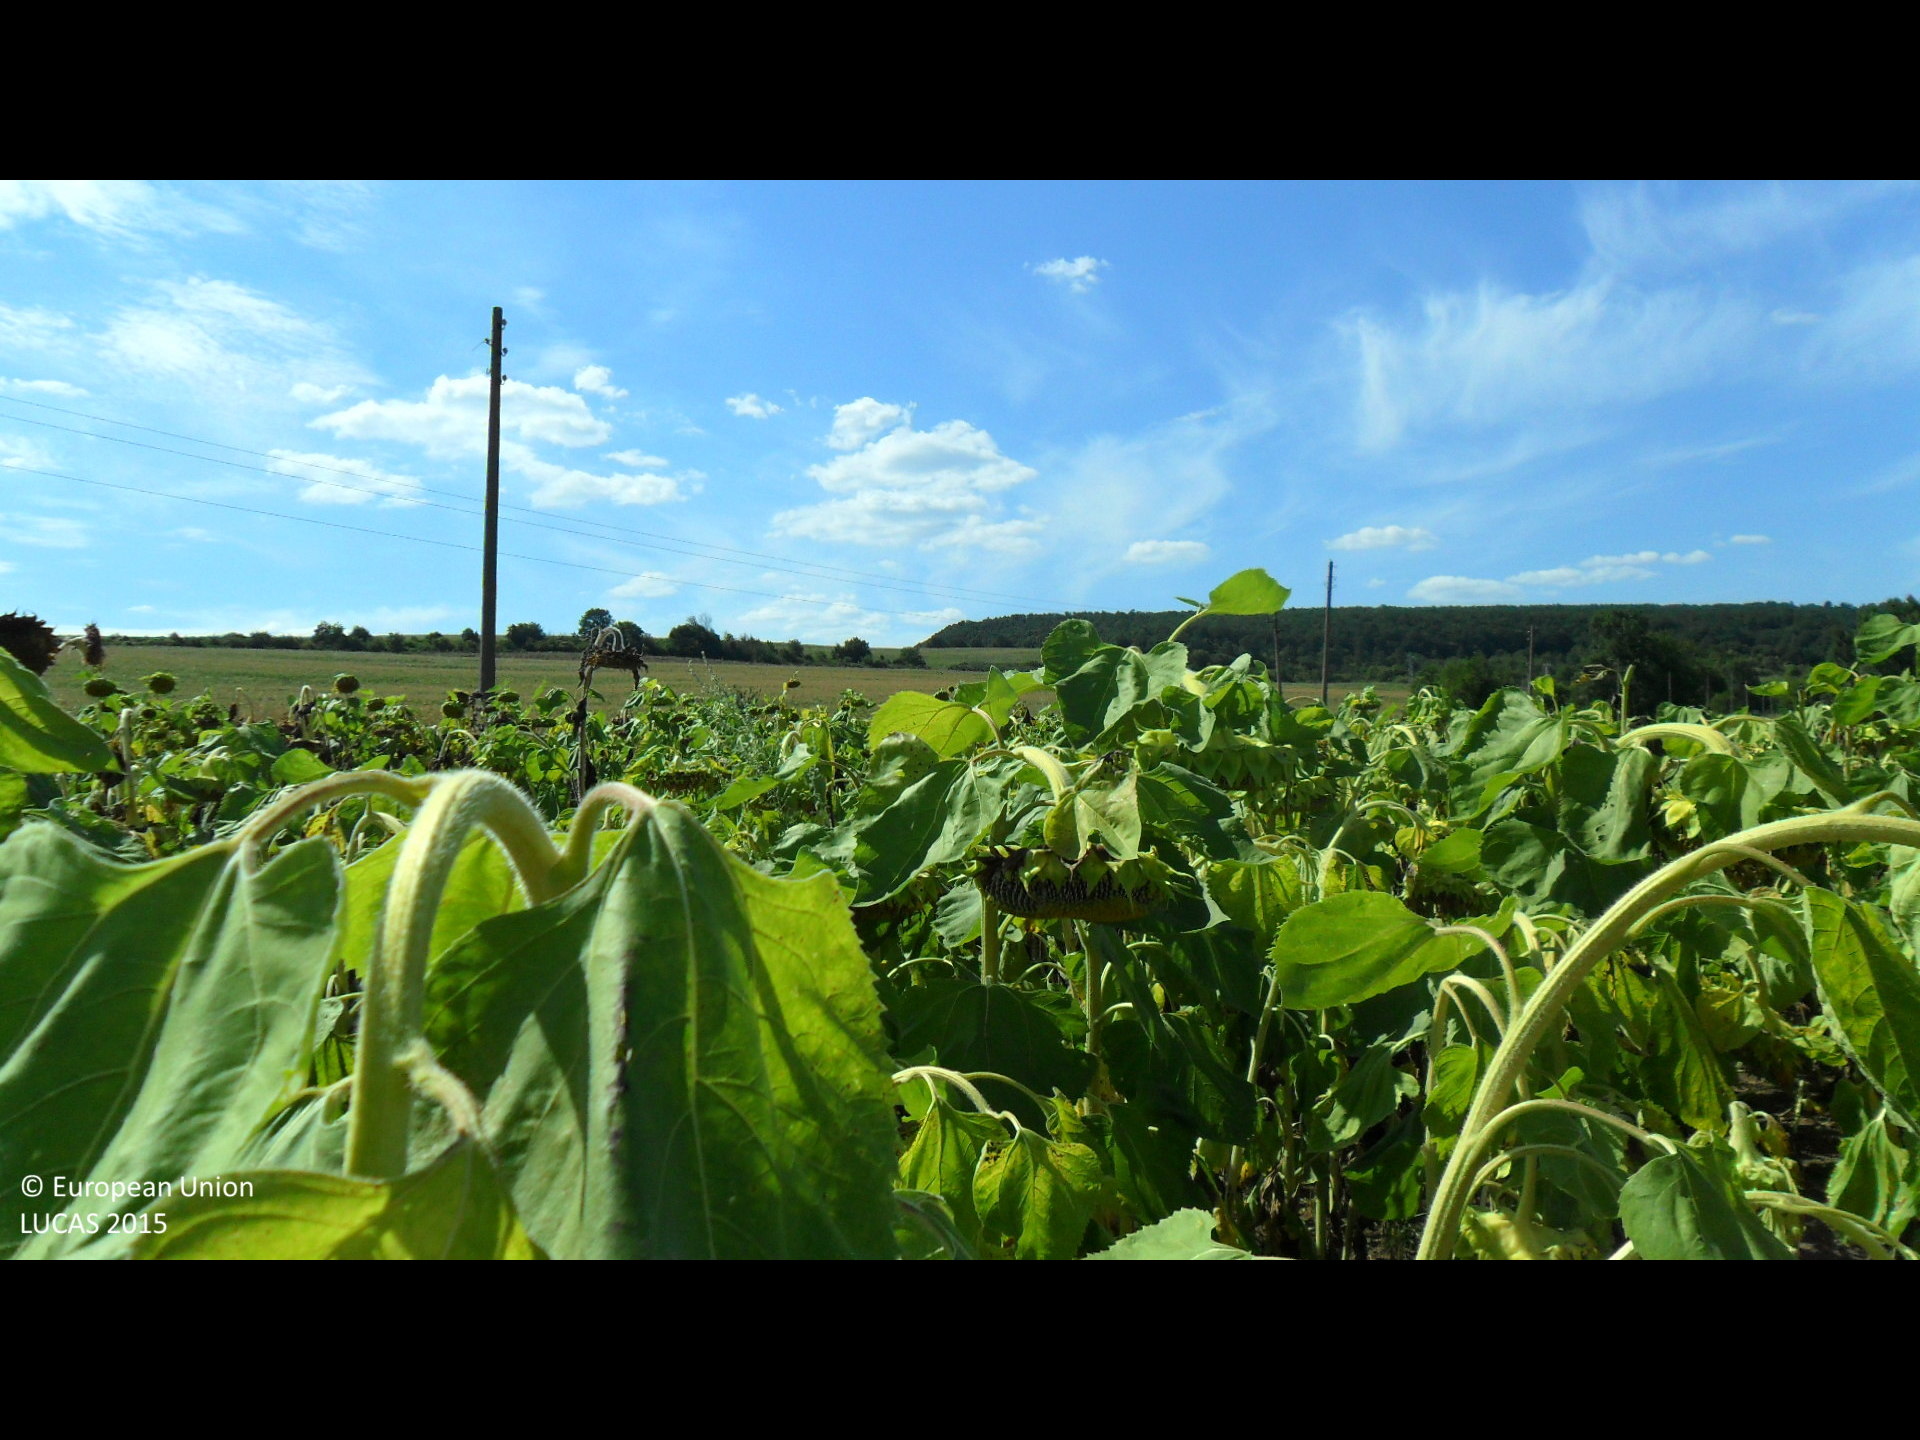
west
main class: Cropland
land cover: Sunflower
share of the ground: > 75 %
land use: Agriculture (excluding fallow land and kitchen gardens)
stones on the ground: < 10 %
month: August
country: BG
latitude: 43.3206
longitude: 26.3386
